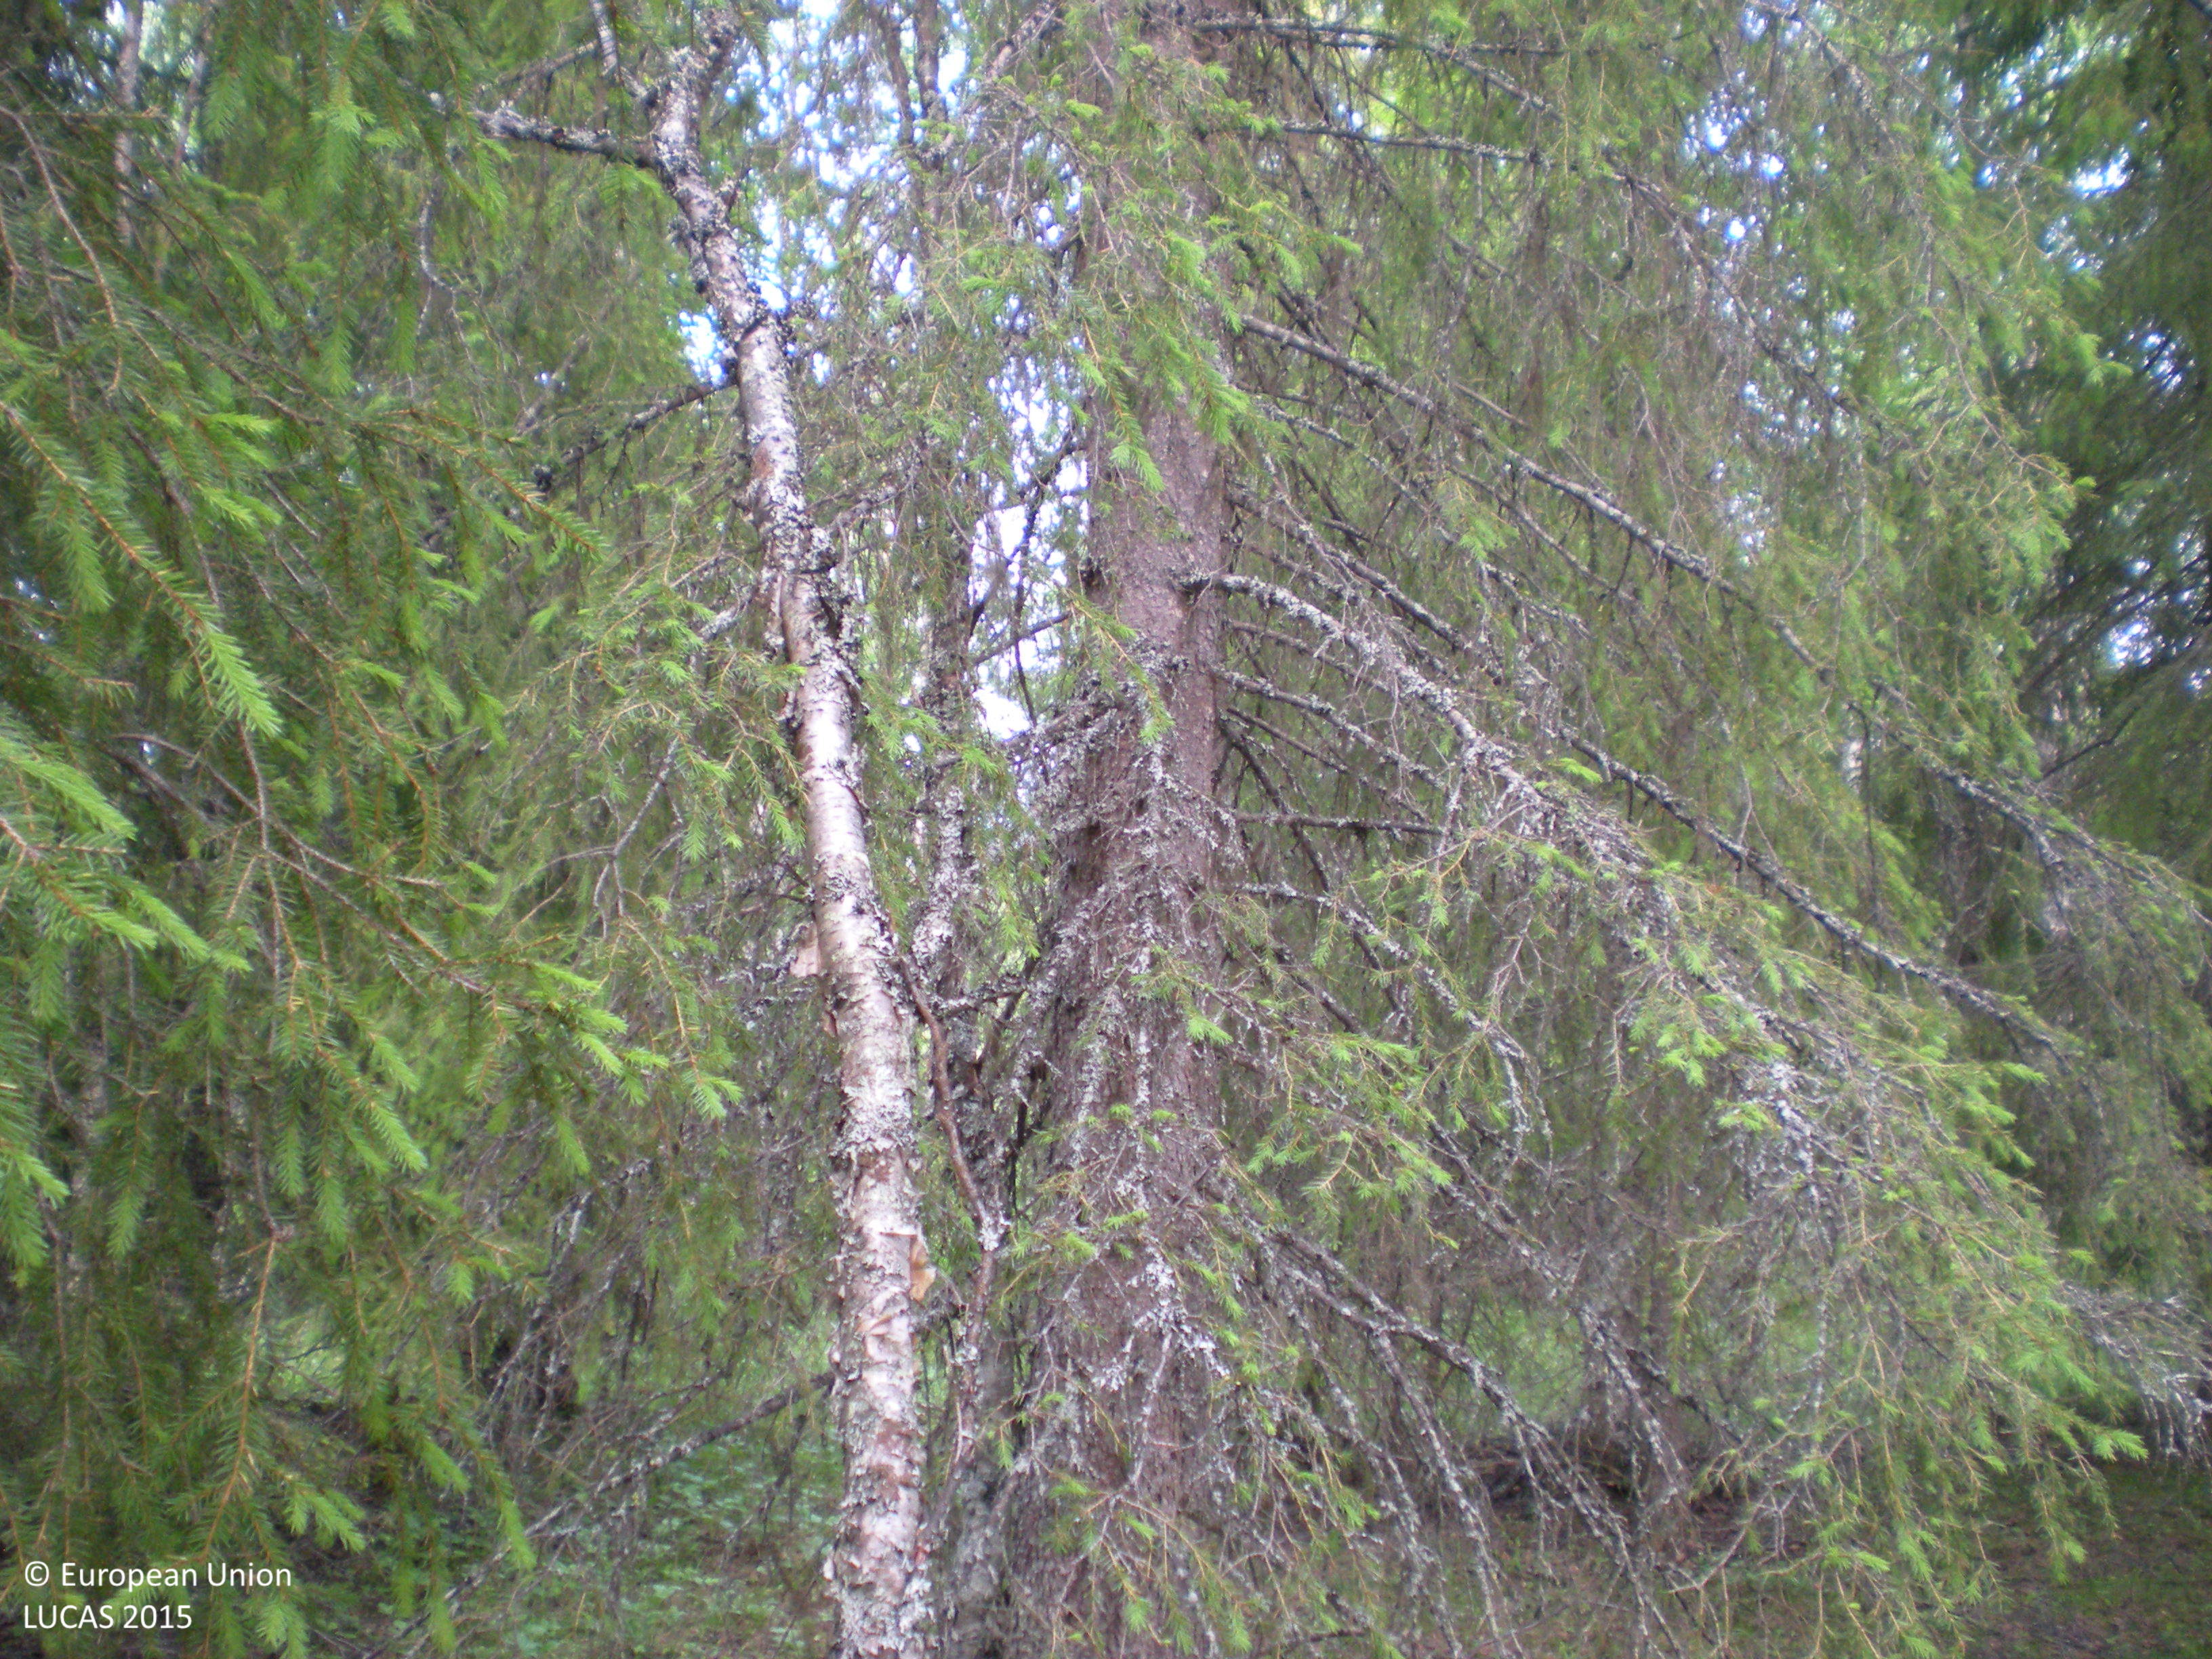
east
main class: Woodland
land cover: Spruce dominated mixed woodland
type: boreal forest
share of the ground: 50 - 75 %
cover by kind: coniferous forest trees 45 %, broadleaved forest trees 30 %, herbaceous plants 15 %, shrubs 5 %, lichens and mosses 5 %
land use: Forestry
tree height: > 5 m
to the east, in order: Spruce dominated mixed woodland; Ditches and canals; Broadleaved woodland; Paved roads, cycling and walking lanes; Other bare soil; Spruce dominated mixed woodland
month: July
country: SE
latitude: 65.6959
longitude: 16.9922
